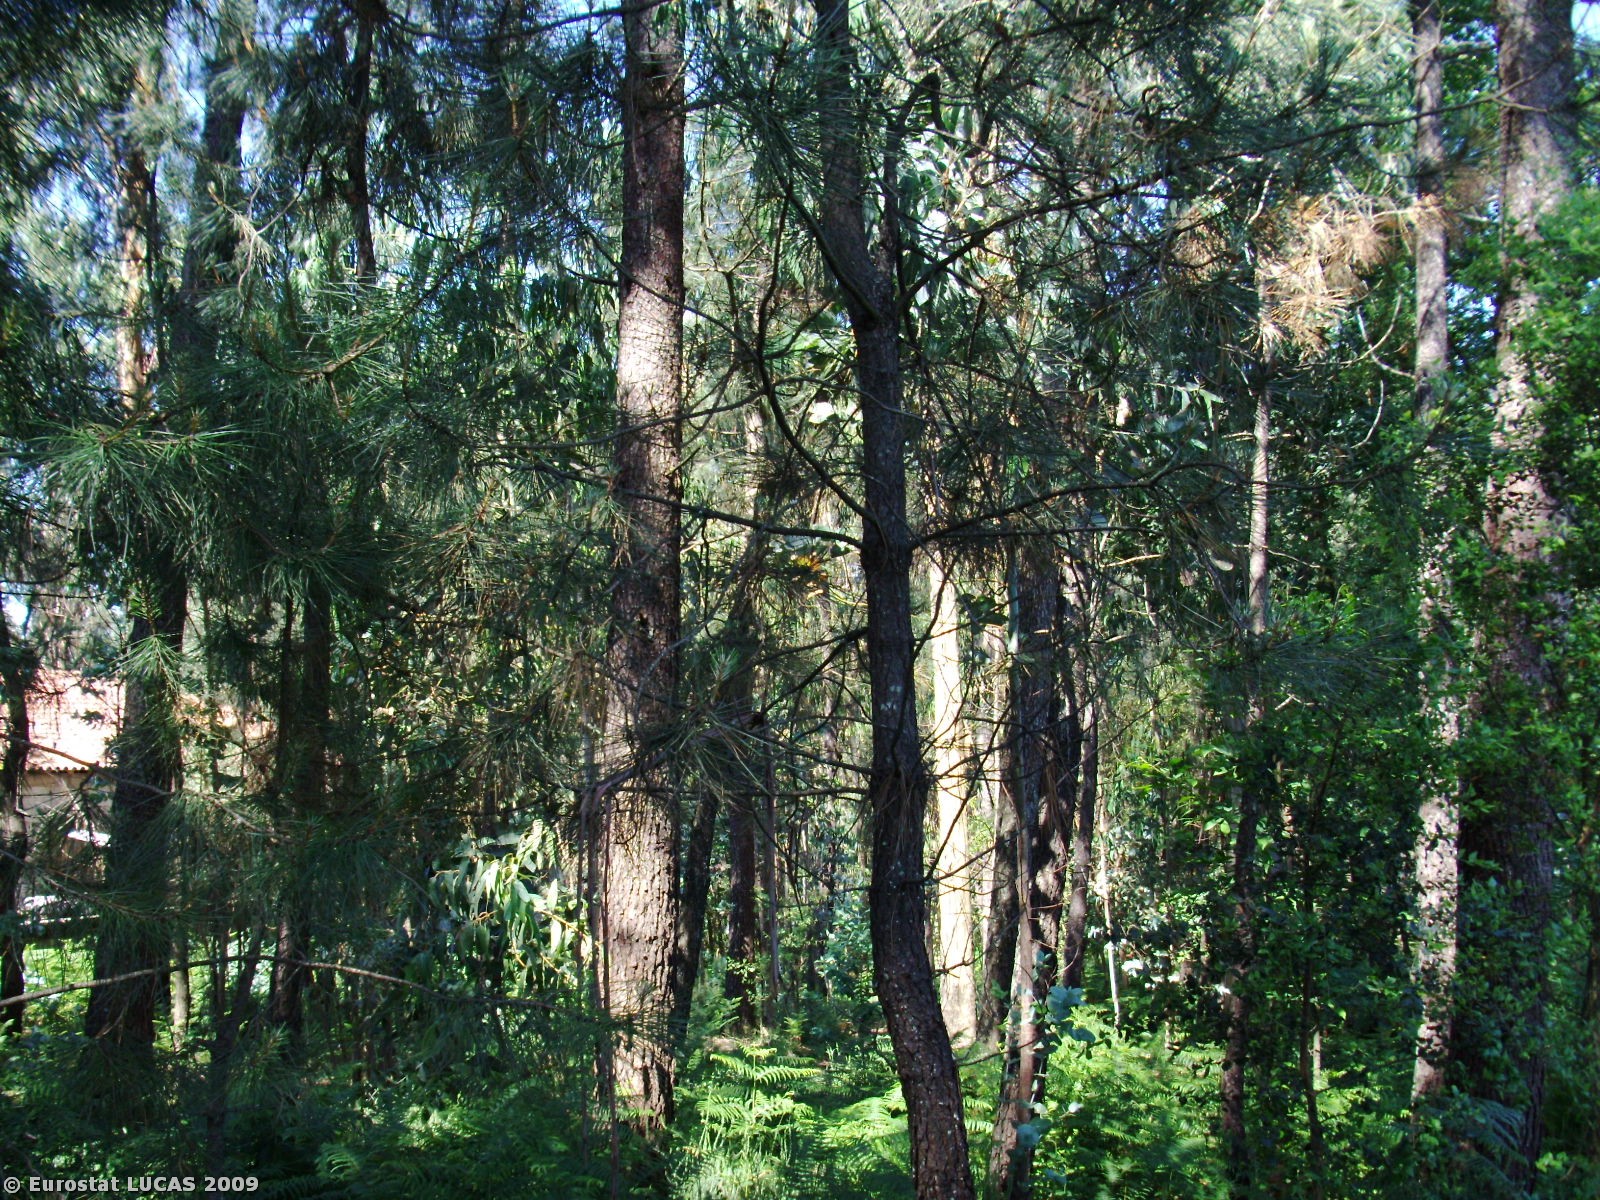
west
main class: Woodland
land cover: Mixed woodland
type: coniferous forest of the mediterranean region
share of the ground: > 75 %
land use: Forestry
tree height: > 5 m
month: May
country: PT
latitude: 41.5971
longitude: -8.5999
